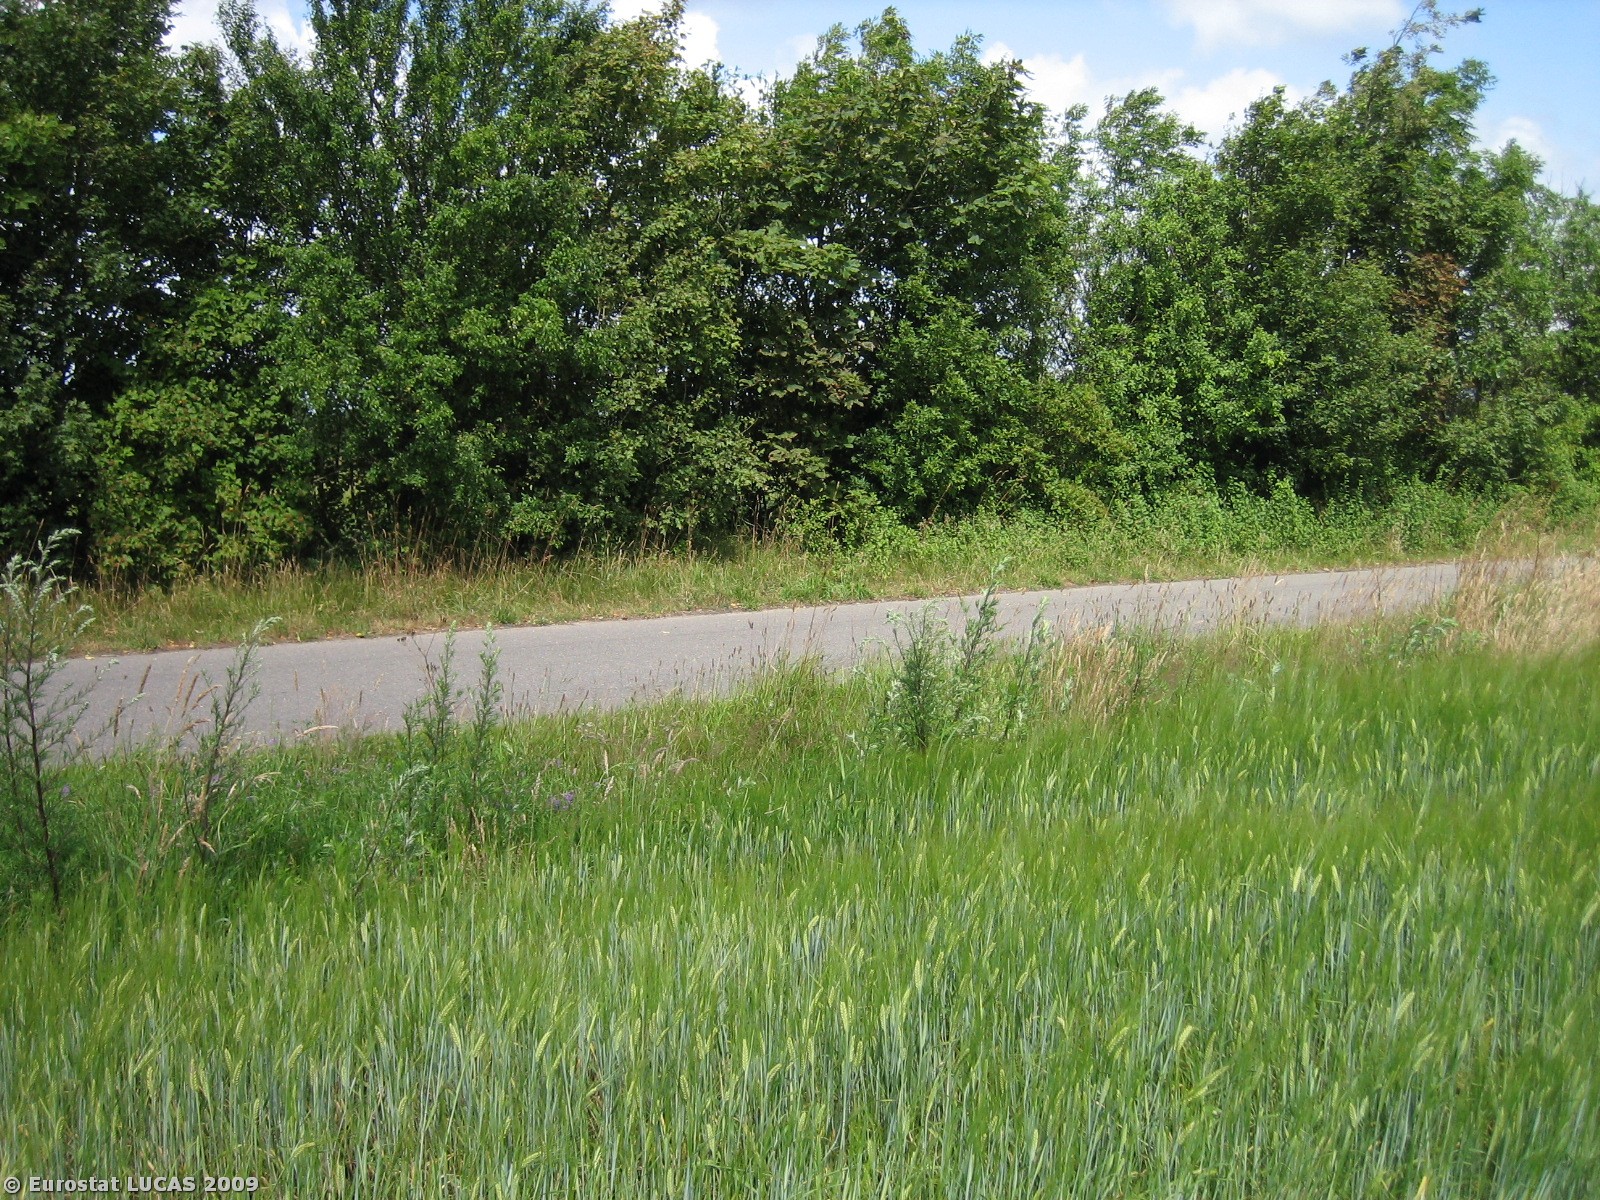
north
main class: Cropland
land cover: Barley
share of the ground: > 75 %
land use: Agriculture (excluding fallow land and kitchen gardens)
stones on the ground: < 10 %
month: July
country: DK
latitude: 55.6942
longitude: 8.5536
